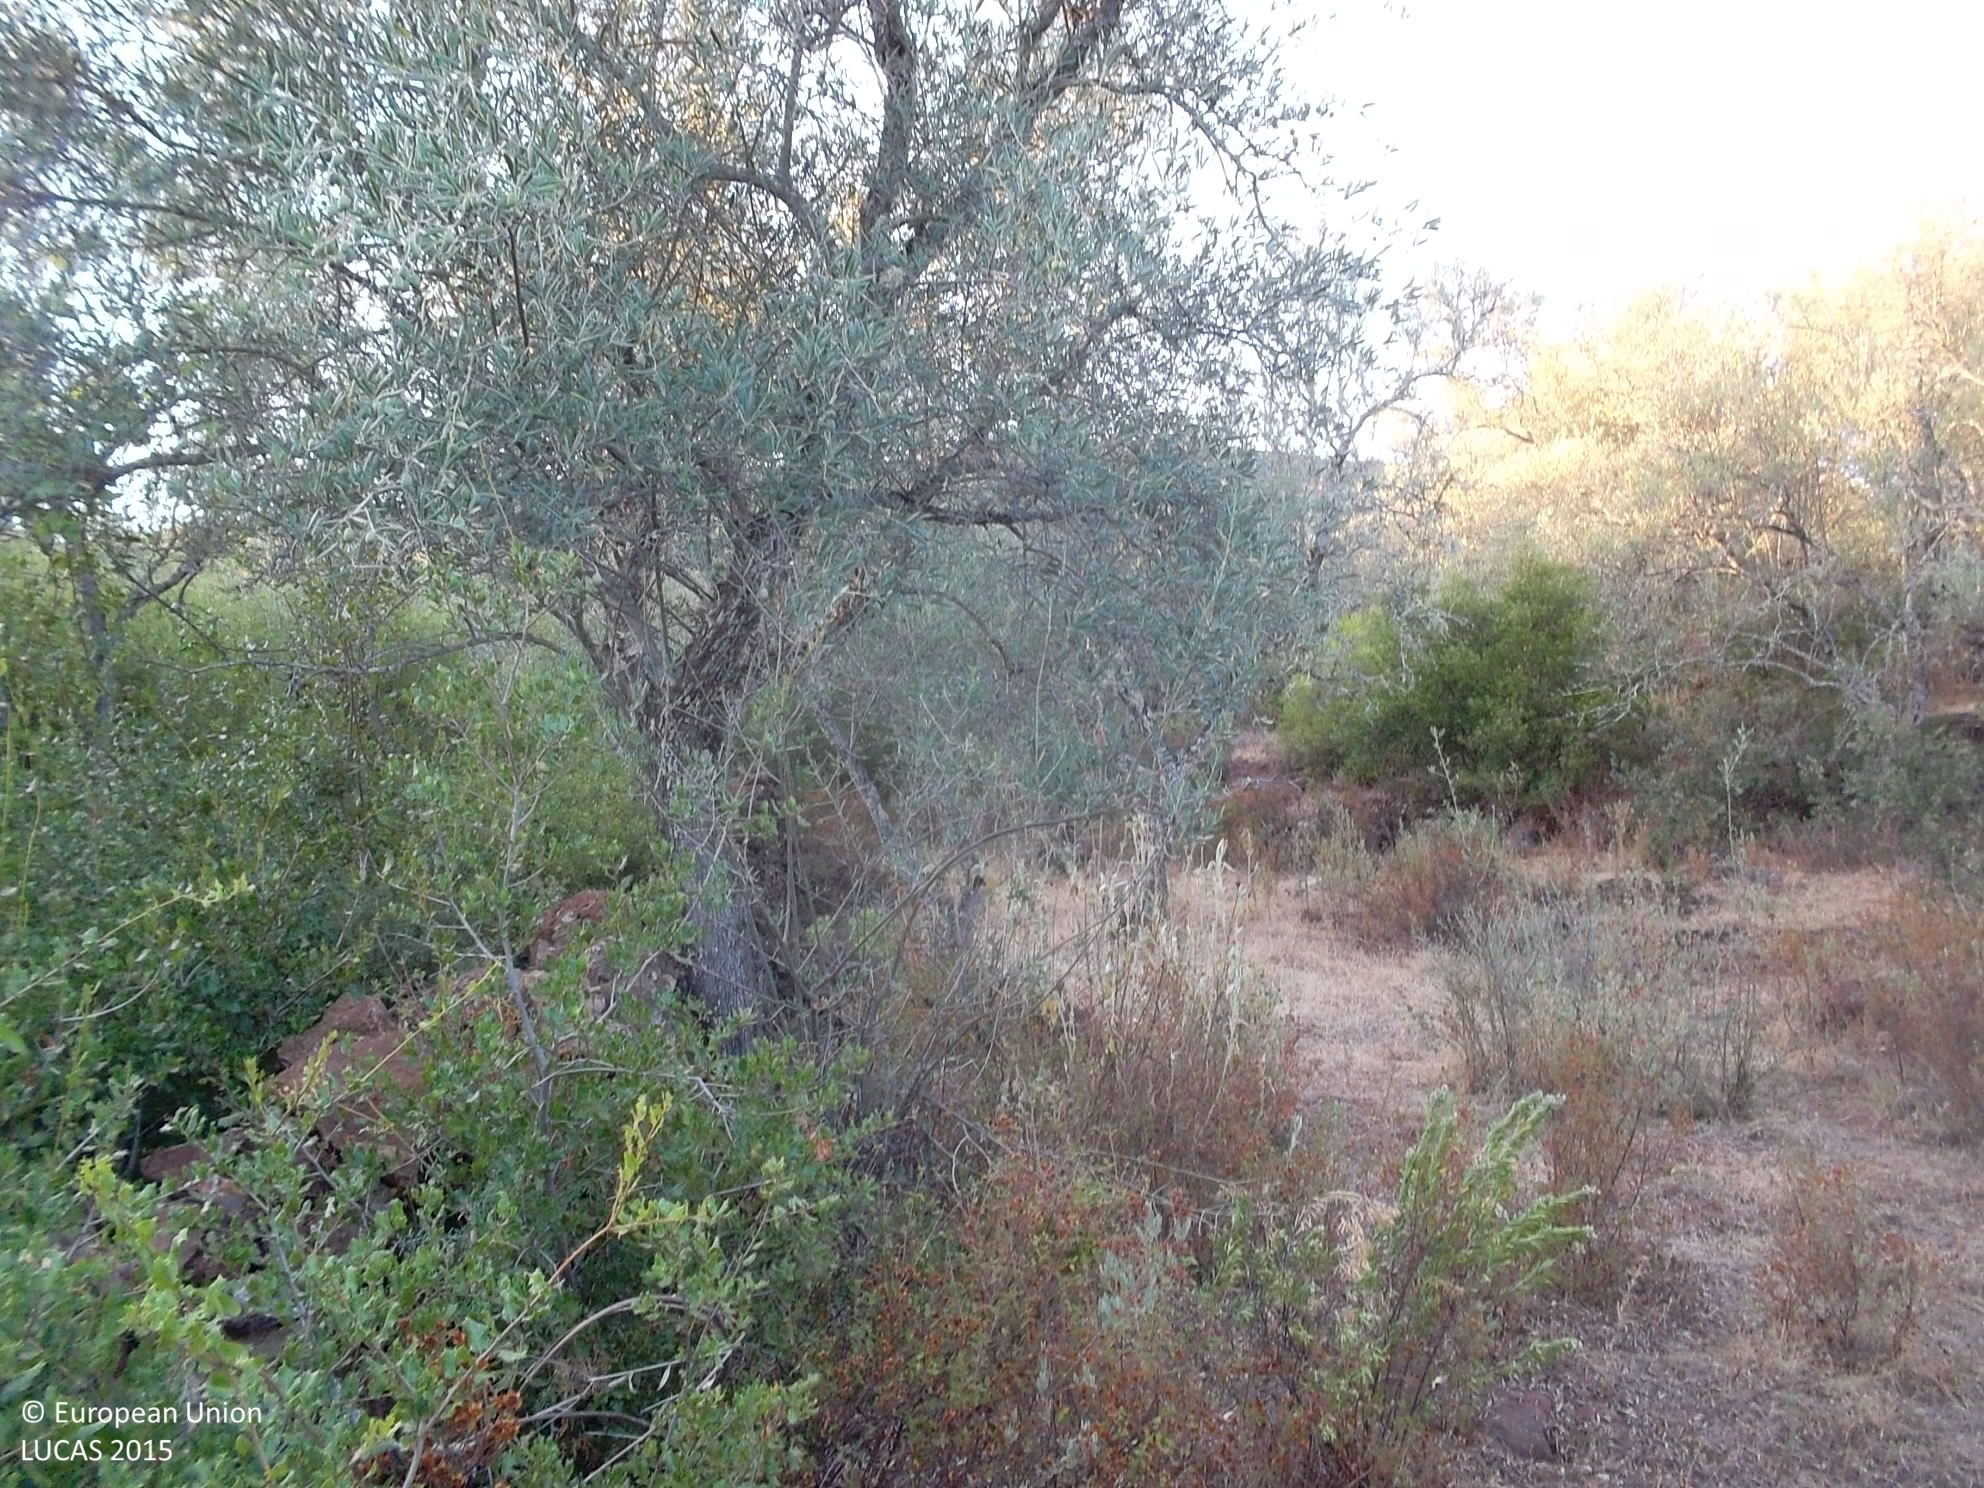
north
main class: Cropland
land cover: Olive groves
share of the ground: 25 - 50 %
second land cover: Shrubland without tree cover
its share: > 75 %
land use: Abandoned areas
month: September
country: ES
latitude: 38.0209
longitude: -6.5514
